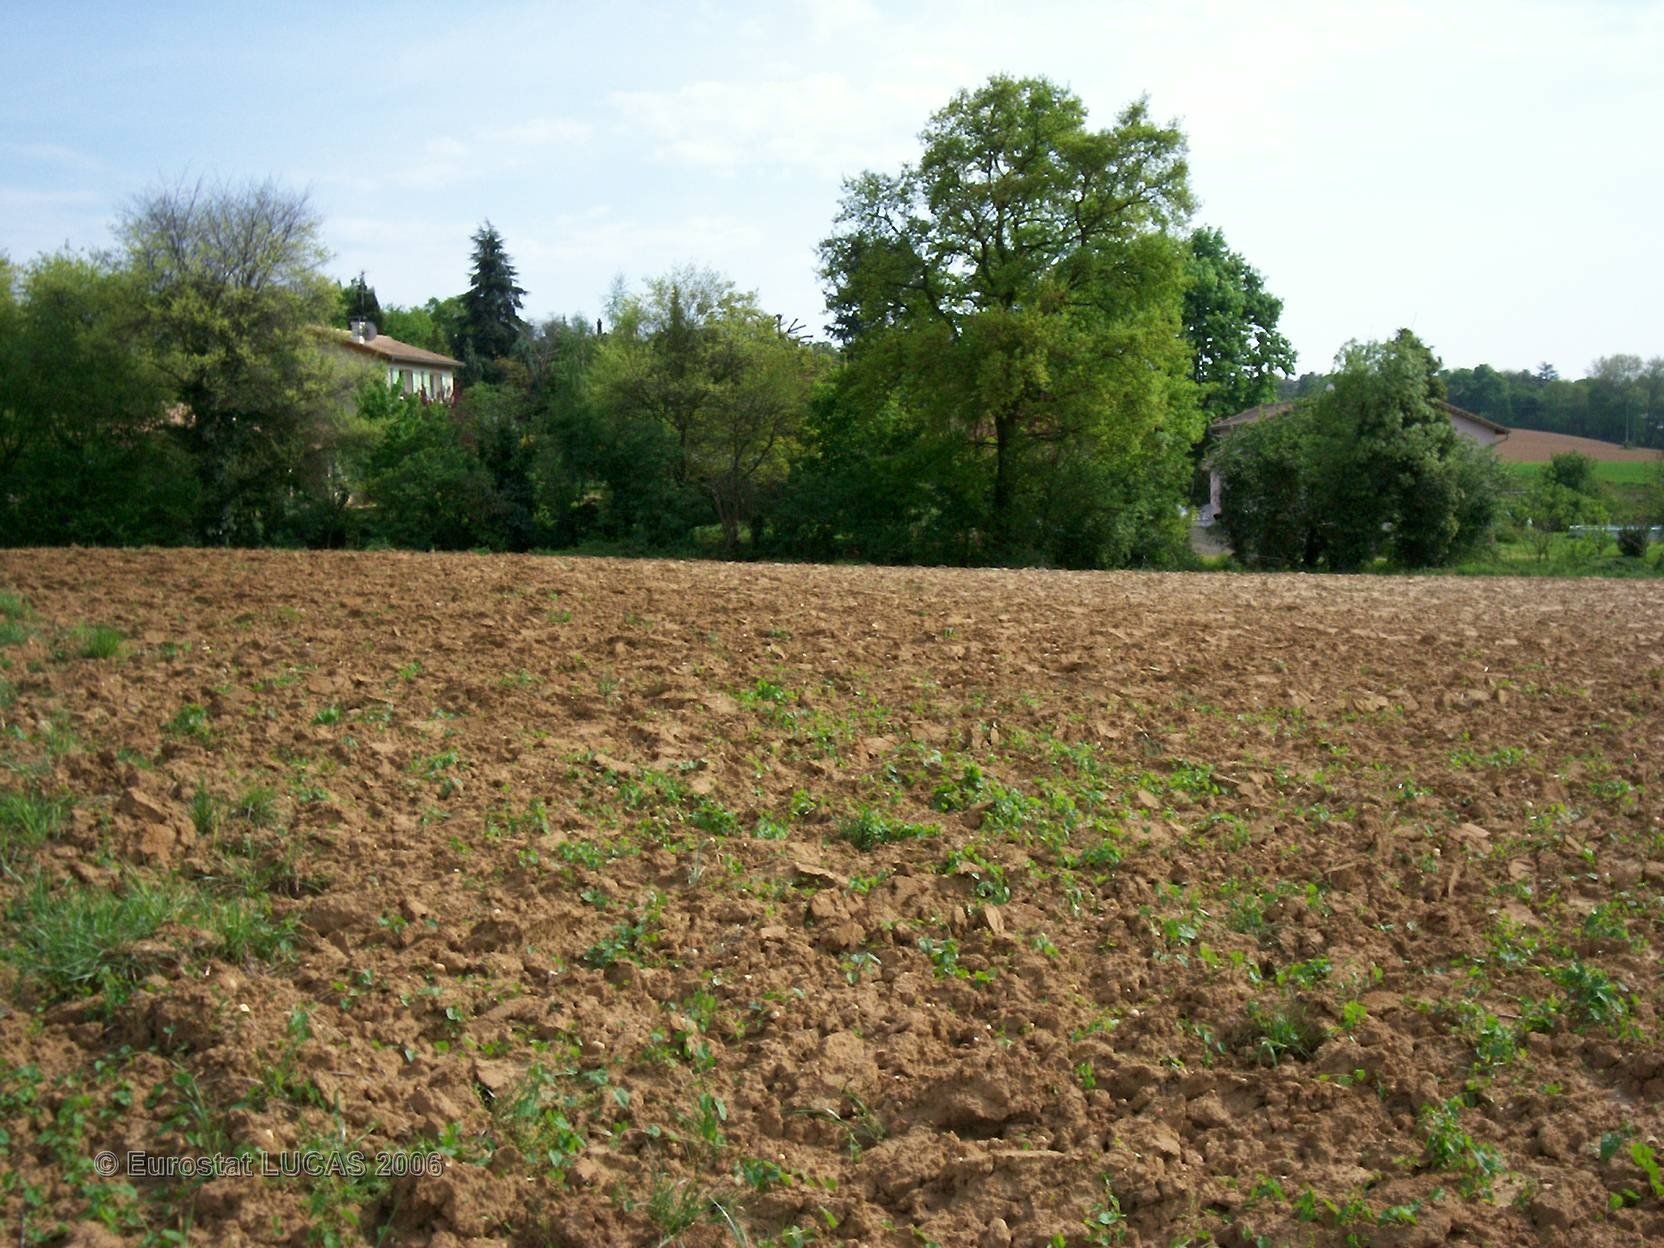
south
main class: Cropland
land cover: Maize
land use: Agriculture (excluding fallow land and kitchen gardens)
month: June
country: FR
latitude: 45.9529
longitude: 4.7779
